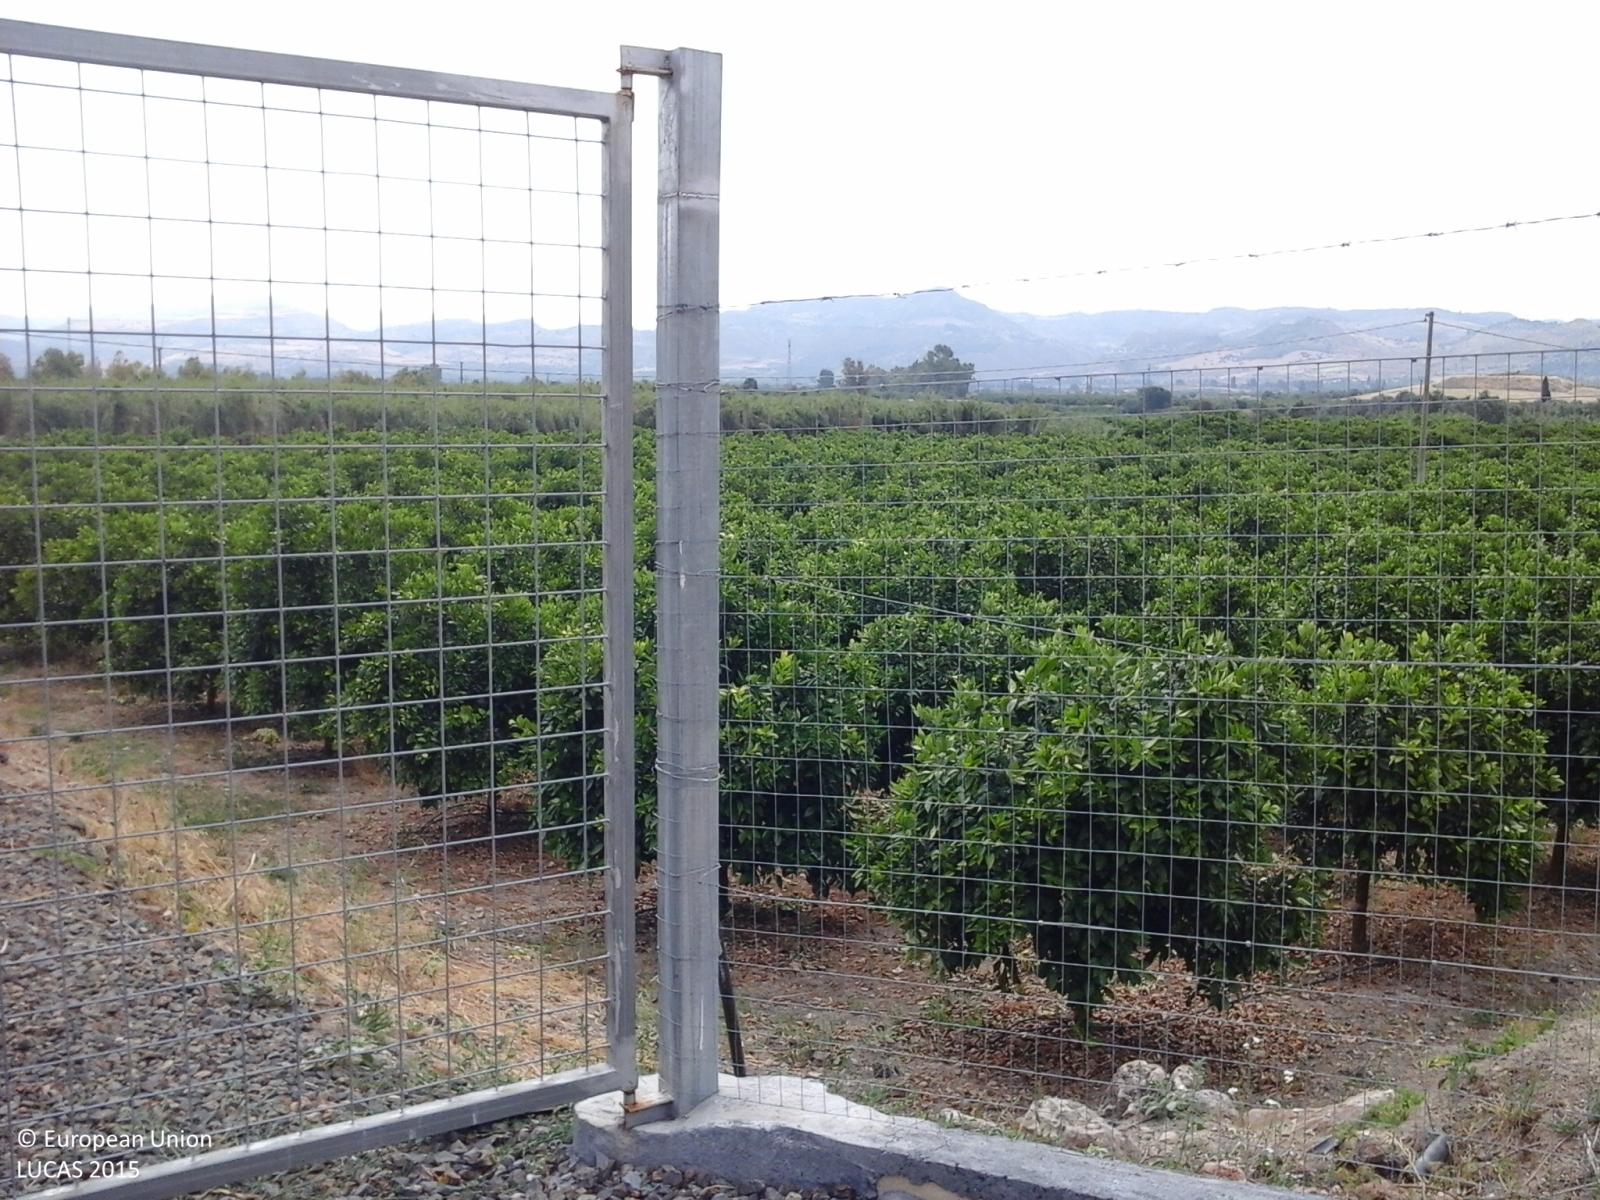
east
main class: Cropland
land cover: Oranges
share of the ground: > 75 %
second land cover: Other bare soil
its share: > 75 %
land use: Agriculture (excluding fallow land and kitchen gardens)
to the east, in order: Oranges; Other bare soil; Grass margins; Tracks; Grass margins; Oranges; Shrubland without tree cover; Inland fresh running water; Shrubland without tree cover; Grass margins; Lines of trees; Grass margins; Oranges; Grass margins; Tracks; Grass margins
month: June
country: IT
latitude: 37.3055
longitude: 14.6696
